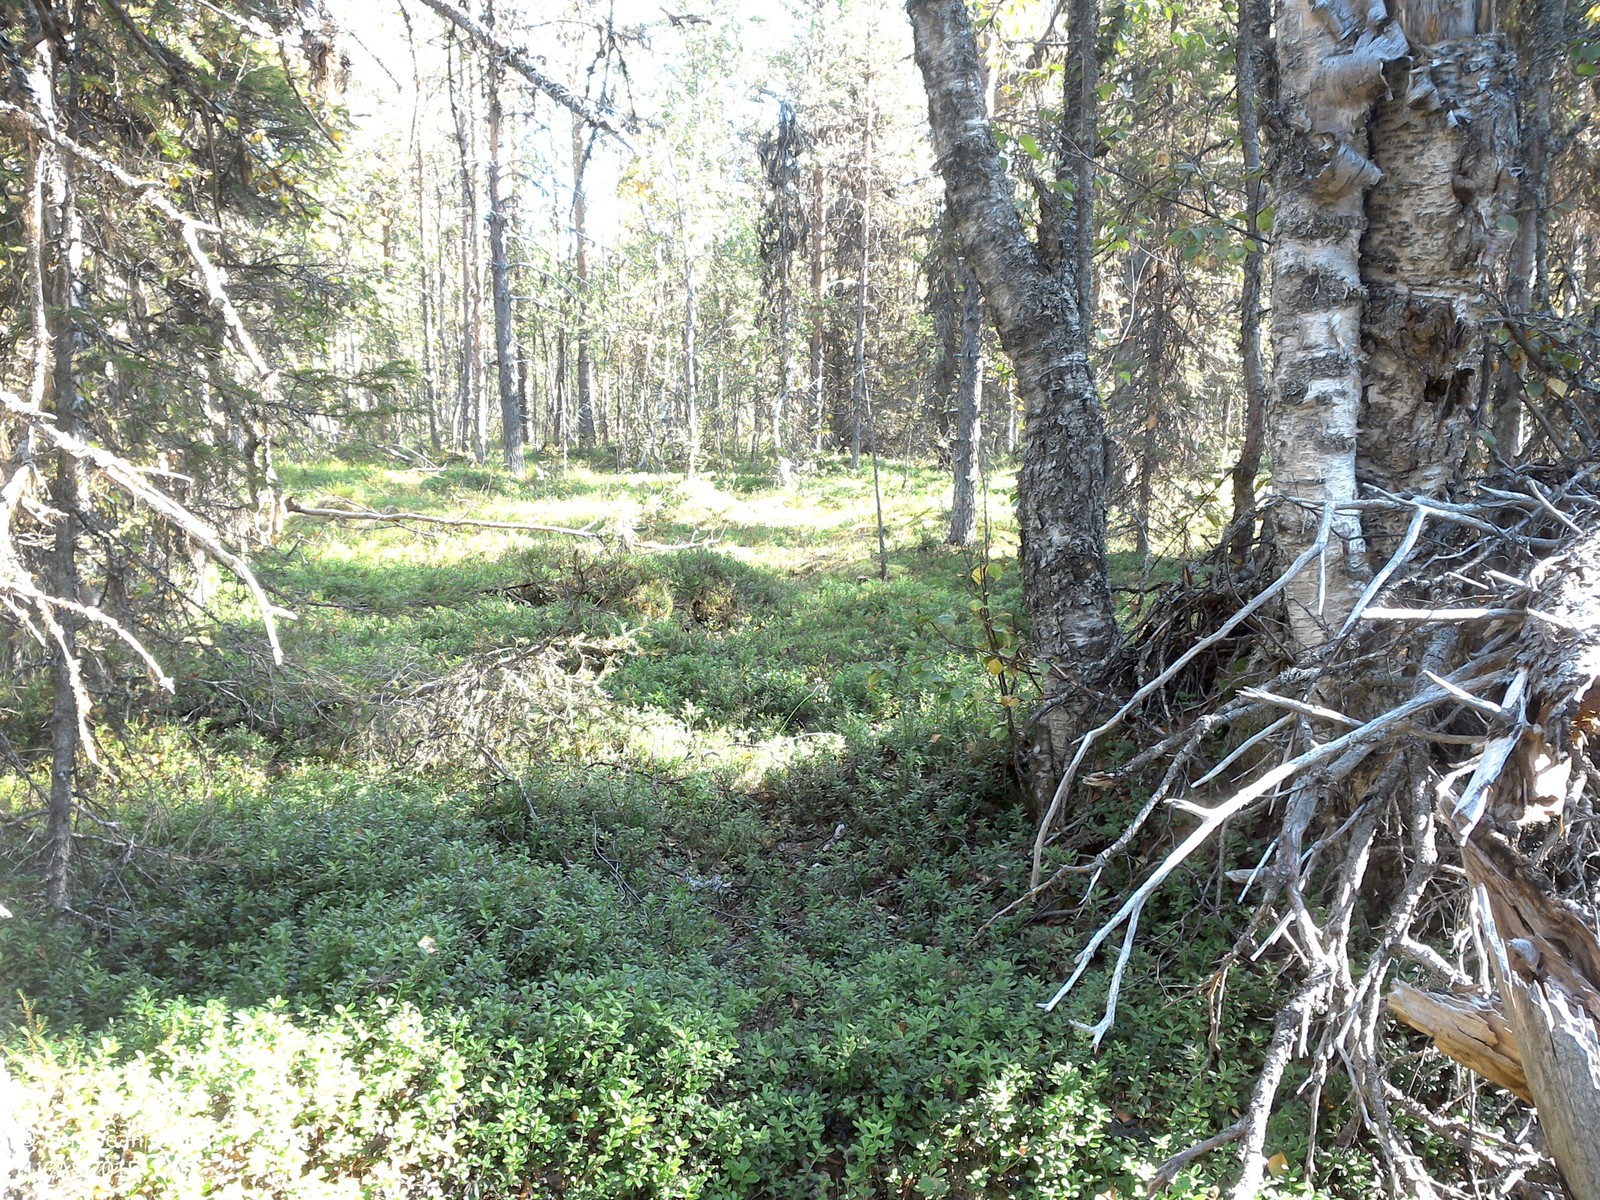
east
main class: Woodland
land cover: Spruce dominated mixed woodland
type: boreal forest
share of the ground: 25 - 50 %
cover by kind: shrubs 50 %, coniferous forest trees 25 %, lichens and mosses 15 %, broadleaved forest trees 10 %
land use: Forestry
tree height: > 5 m
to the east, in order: Spruce dominated mixed woodland; Pine dominated mixed woodland; Spruce dominated mixed woodland
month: August
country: SE
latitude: 67.0953
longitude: 22.0009
